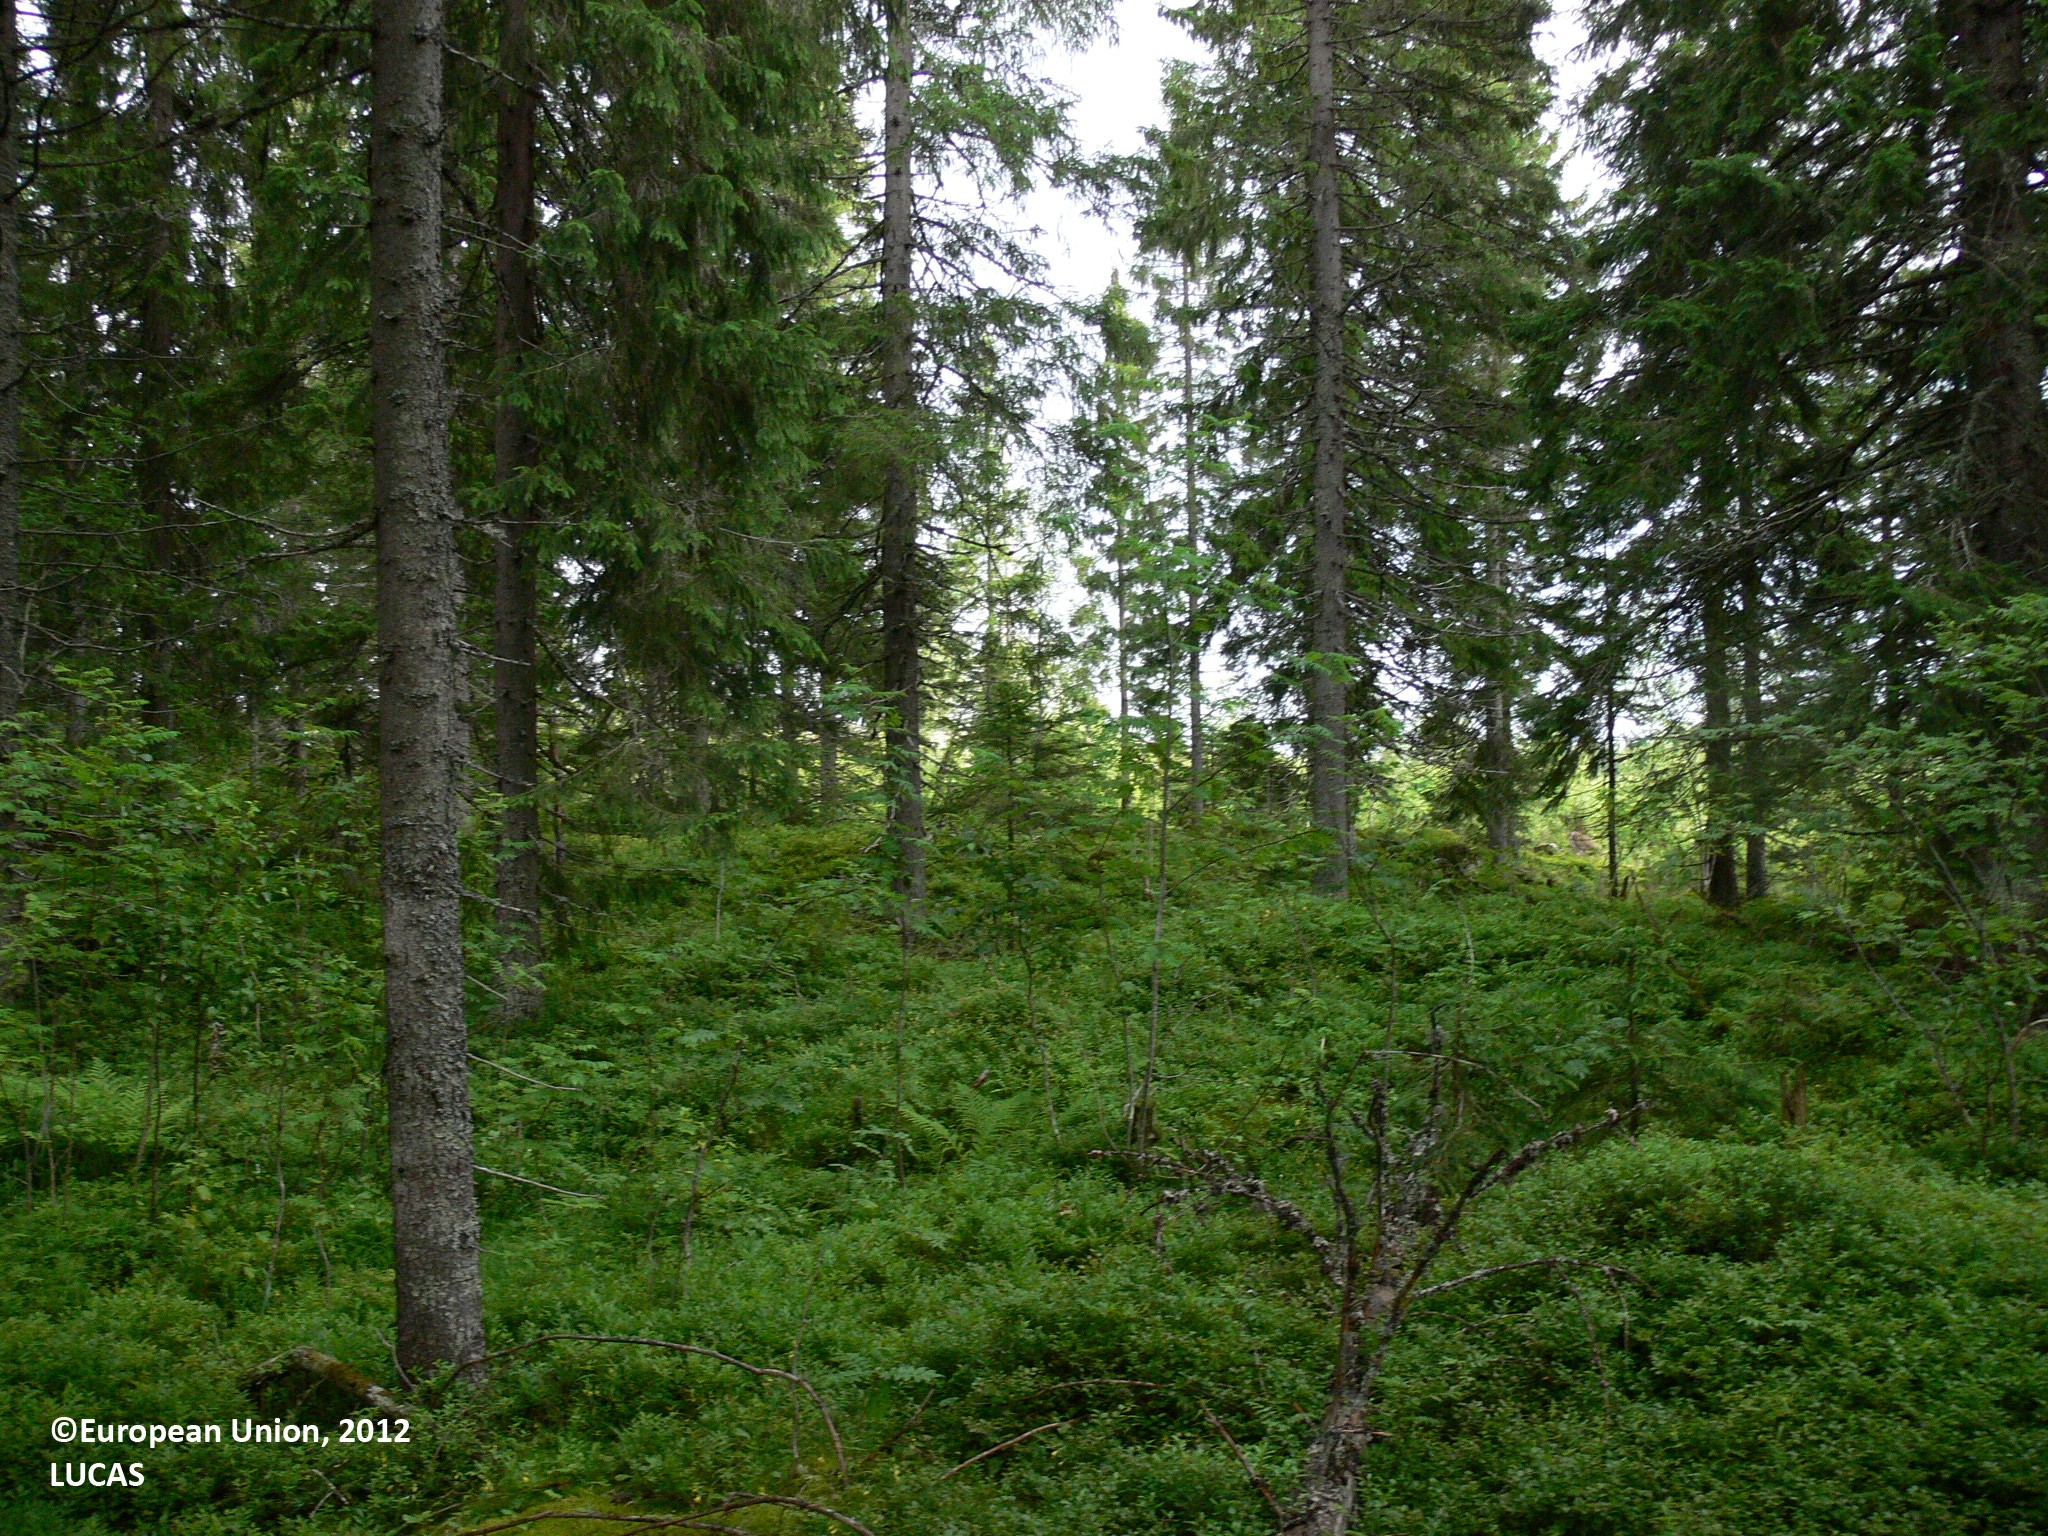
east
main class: Woodland
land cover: Spruce dominated coniferous woodland
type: boreal forest
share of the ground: > 75 %
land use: Forestry
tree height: > 5 m
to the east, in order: Spruce dominated coniferous woodland; Grassland without tree/shrub cover; Electric lines; Grassland without tree/shrub cover; Spruce dominated coniferous woodland; Spruce dominated mixed woodland
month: July
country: FI
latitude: 63.1315
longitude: 29.2000
